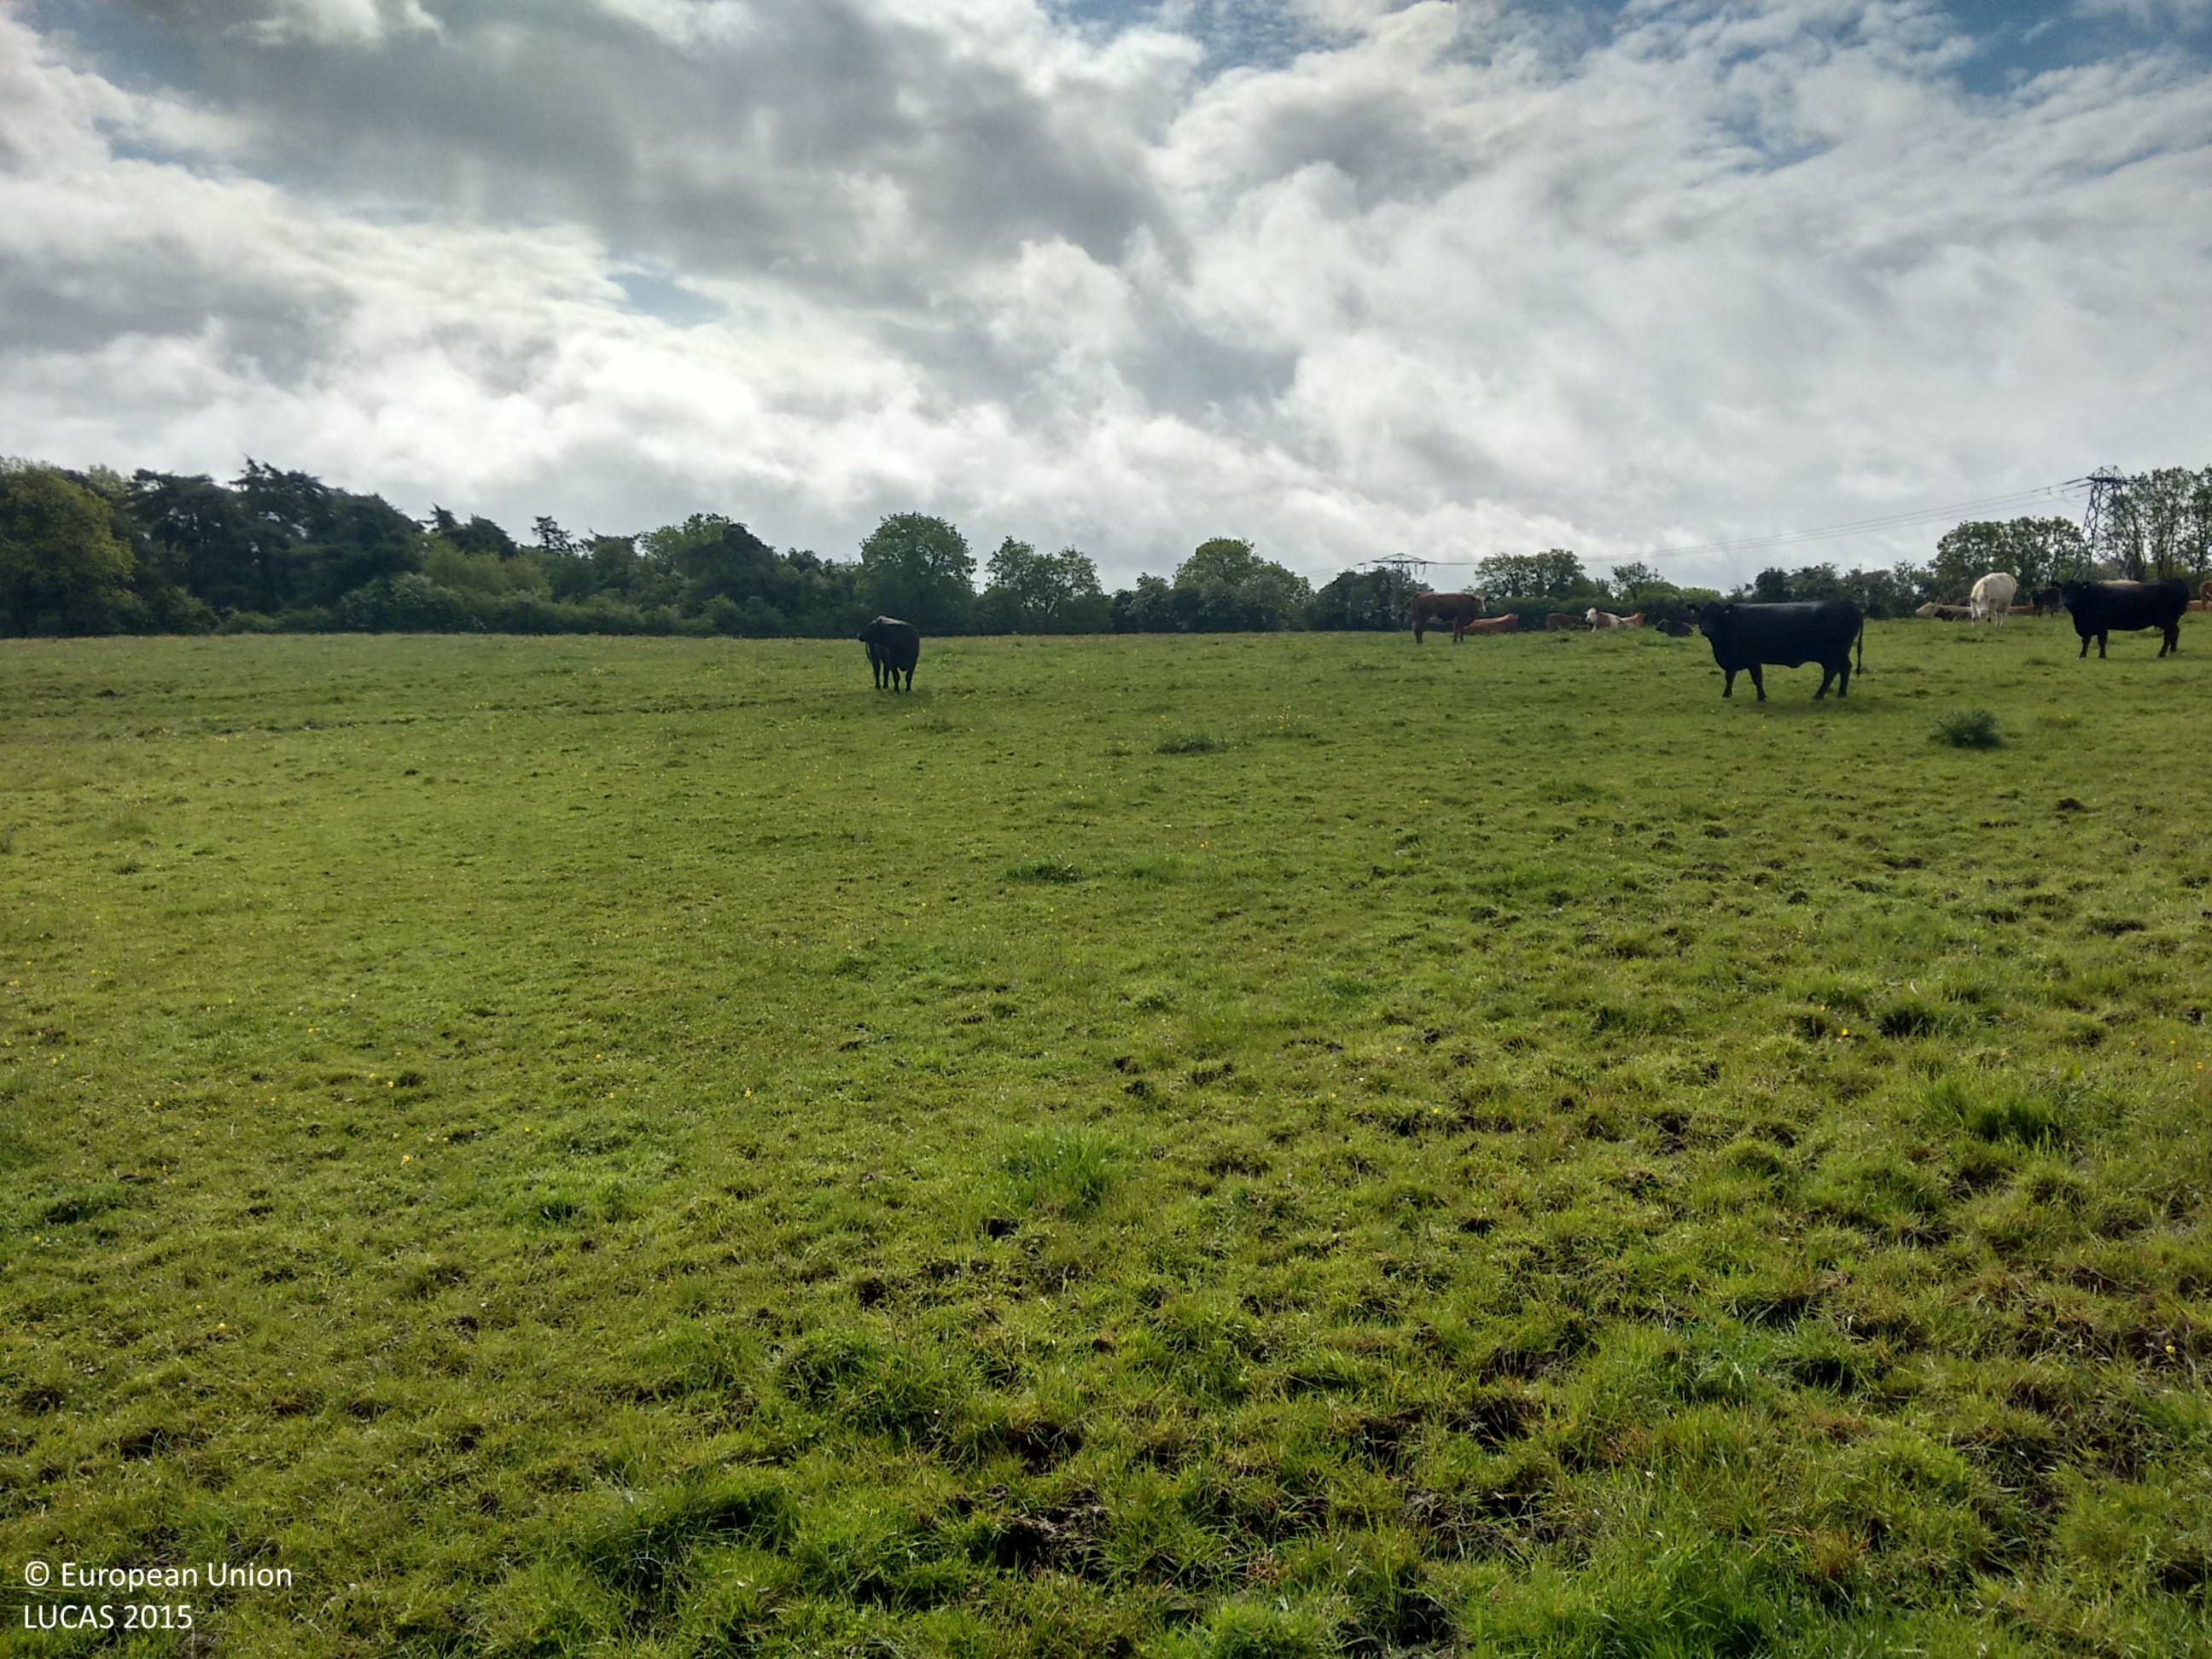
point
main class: Grassland
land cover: Grassland without tree/shrub cover
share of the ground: > 75 %
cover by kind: herbaceous plants 100 %
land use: Agriculture (excluding fallow land and kitchen gardens)
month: June
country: IE
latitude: 53.3961
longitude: -6.9073
